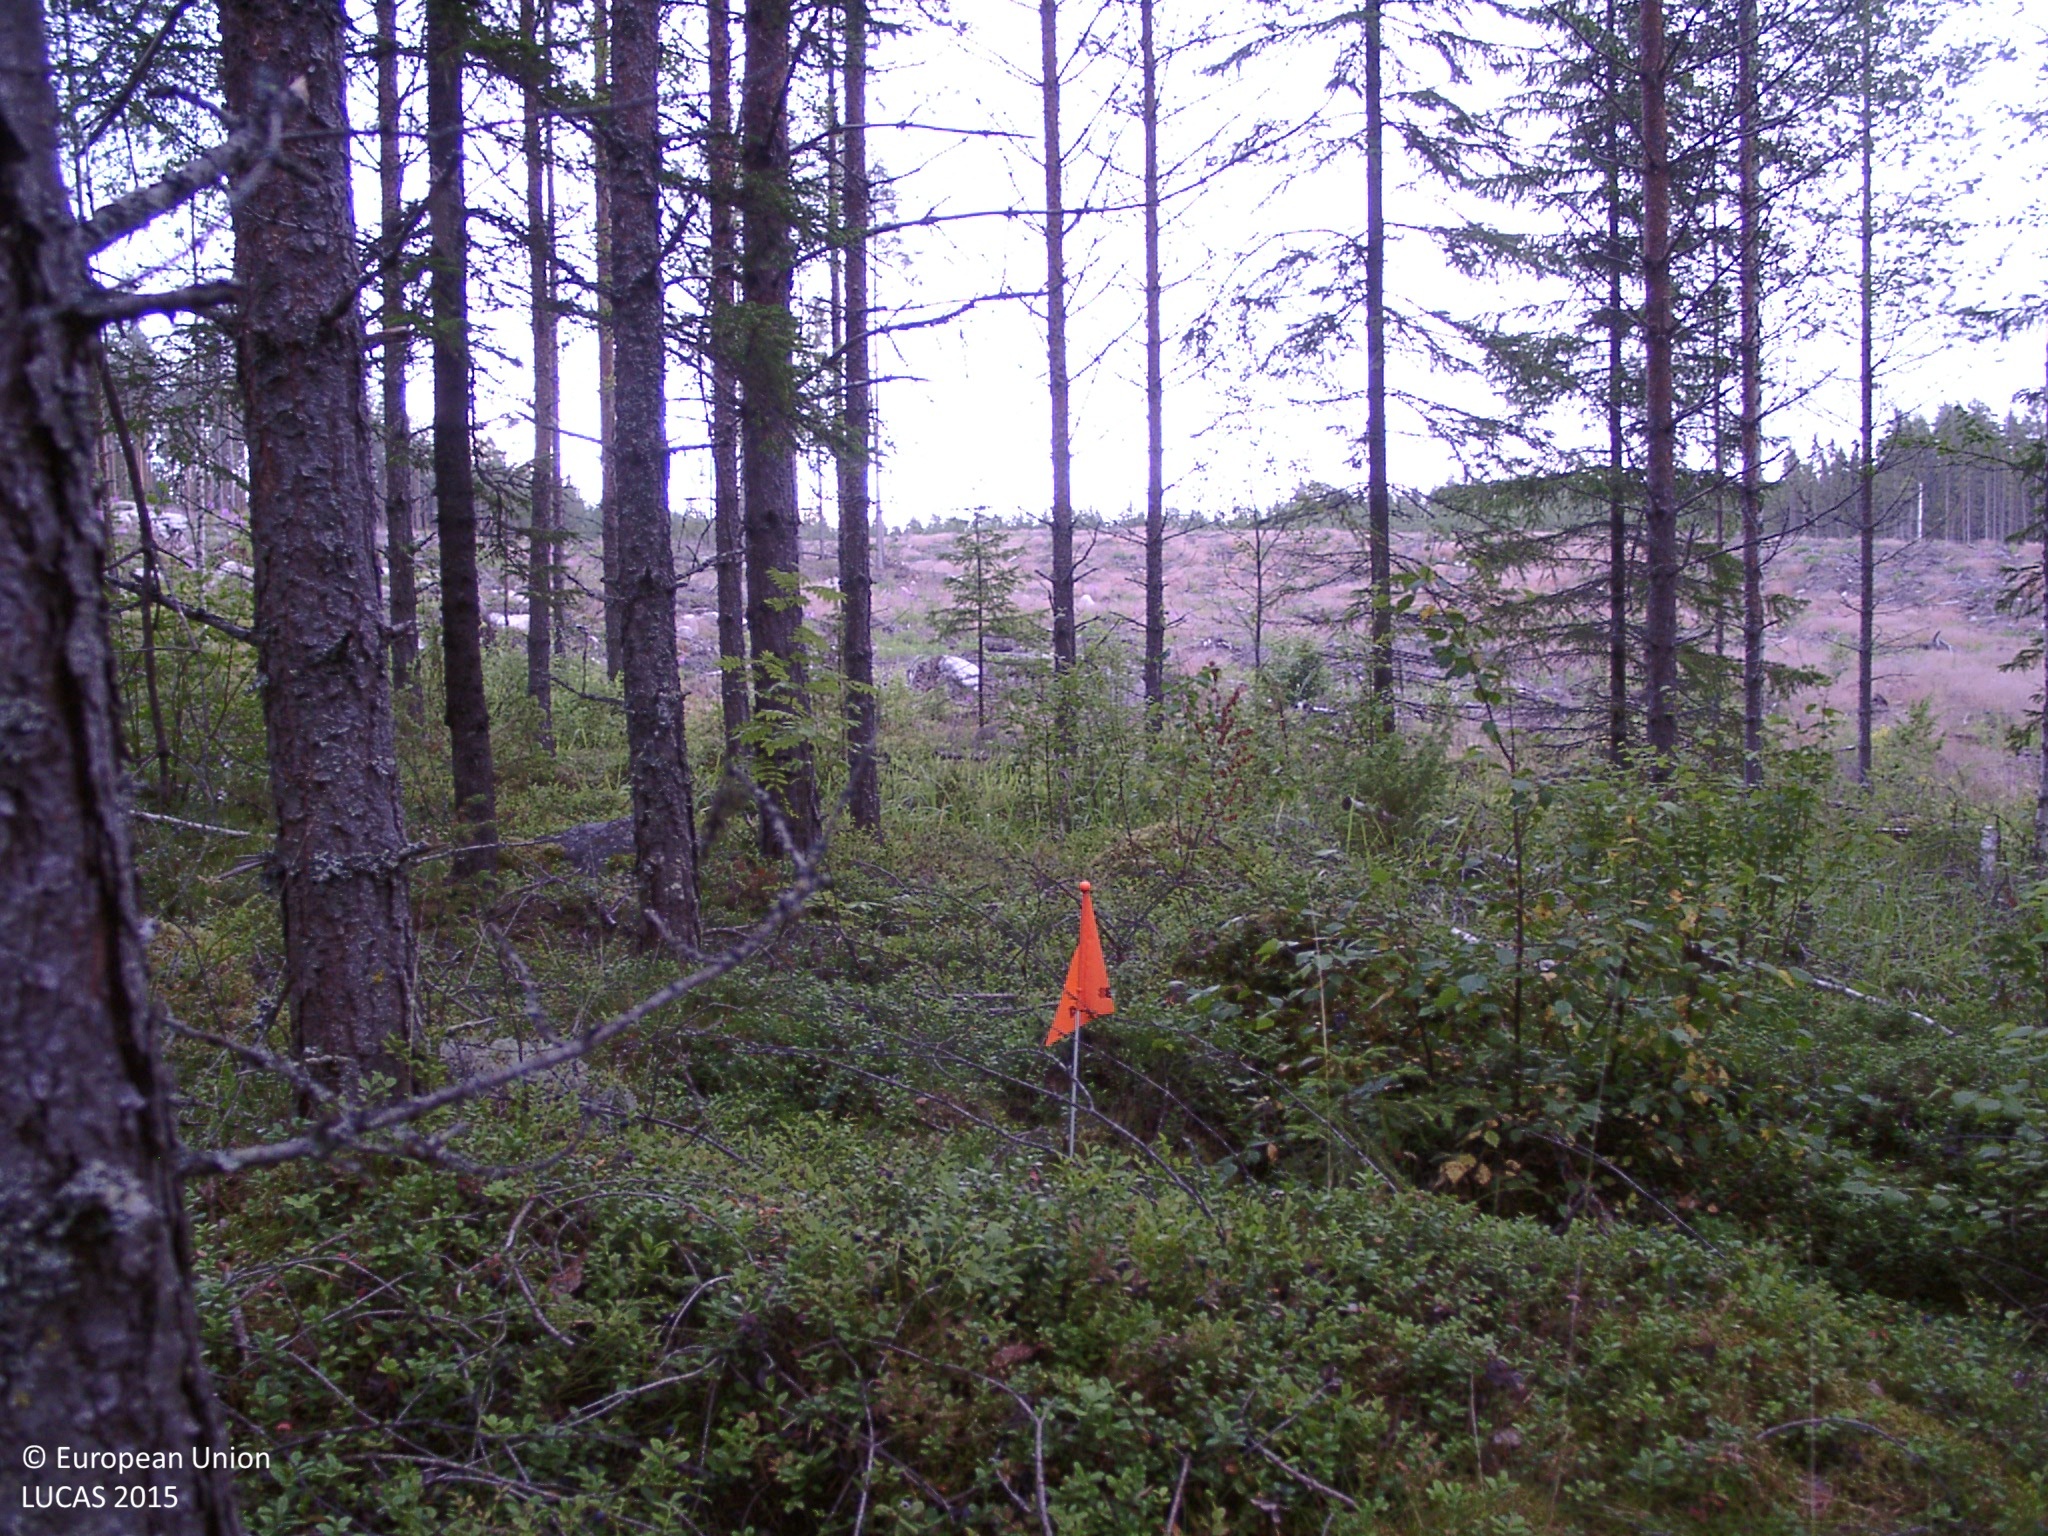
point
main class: Woodland
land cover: Other mixed woodland
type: boreal forest
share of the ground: 50 - 75 %
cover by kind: coniferous forest trees 45 %, broadleaved forest trees 25 %, shrubs 15 %, lichens and mosses 10 %, herbaceous plants 5 %
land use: Forestry
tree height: > 5 m
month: July
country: FI
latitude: 62.3157
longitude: 25.1743
